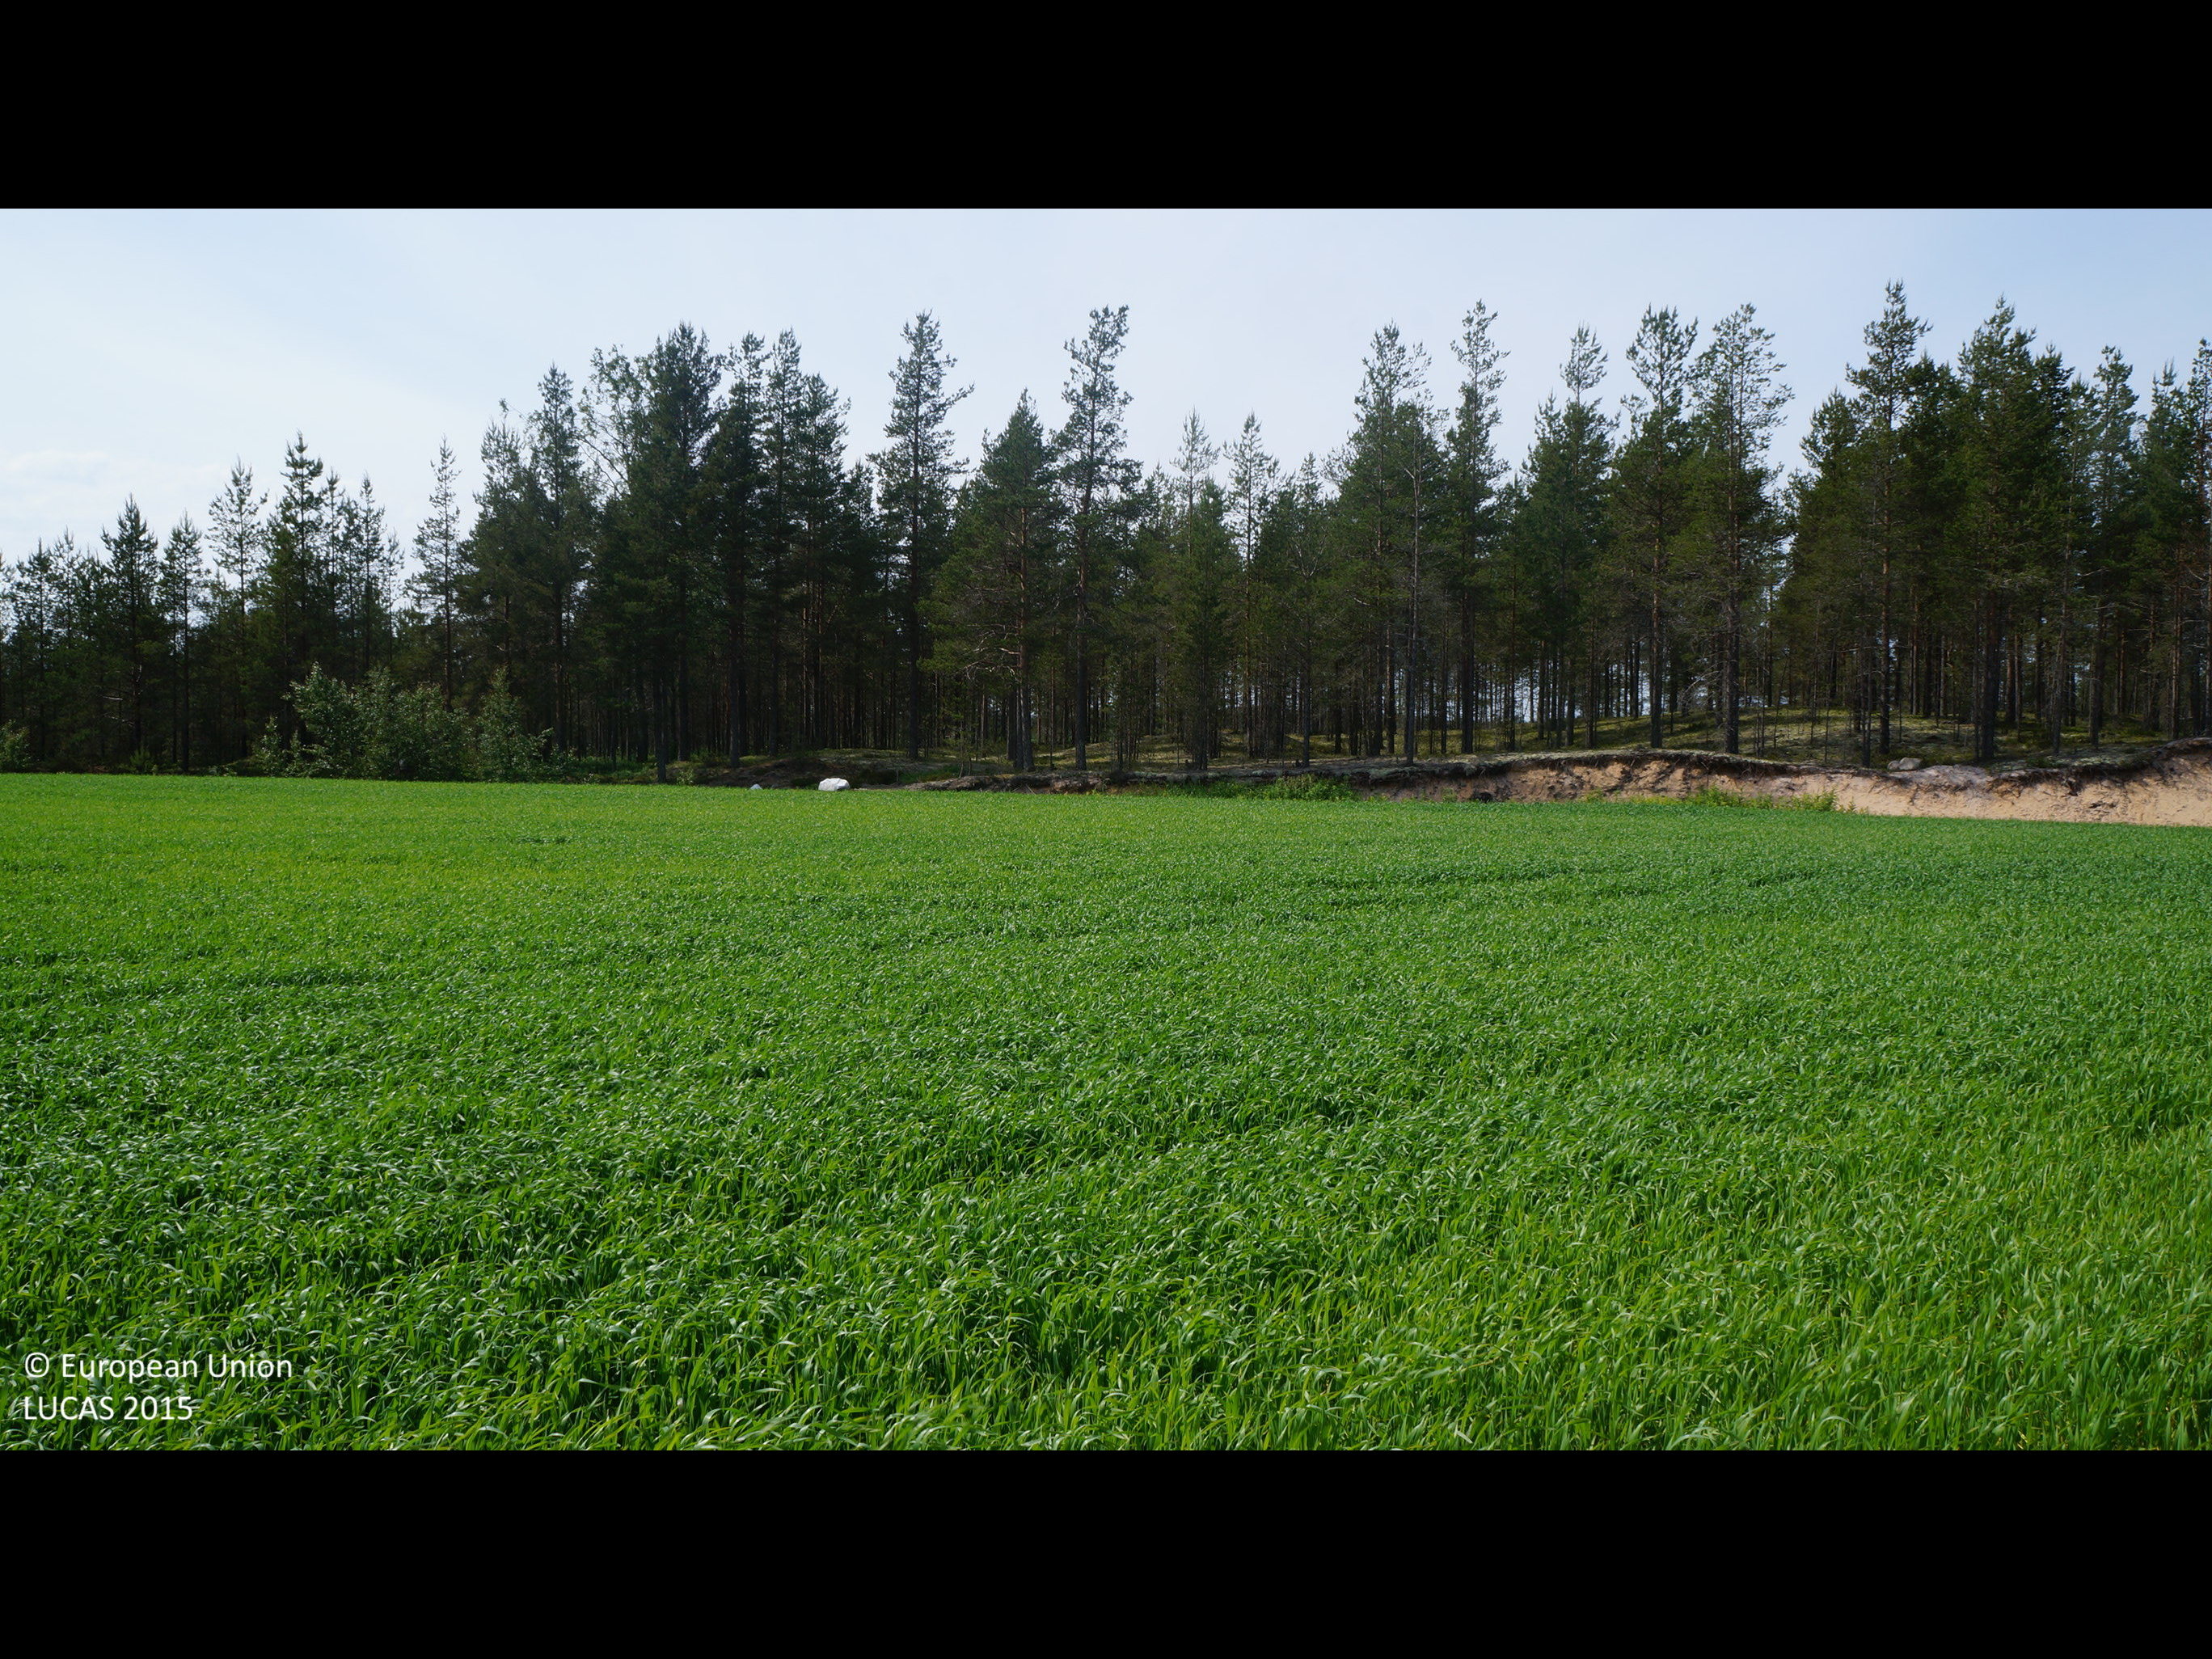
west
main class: Cropland
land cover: Common wheat
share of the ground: > 75 %
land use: Agriculture (excluding fallow land and kitchen gardens)
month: June
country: FI
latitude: 64.1508
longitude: 23.8967
